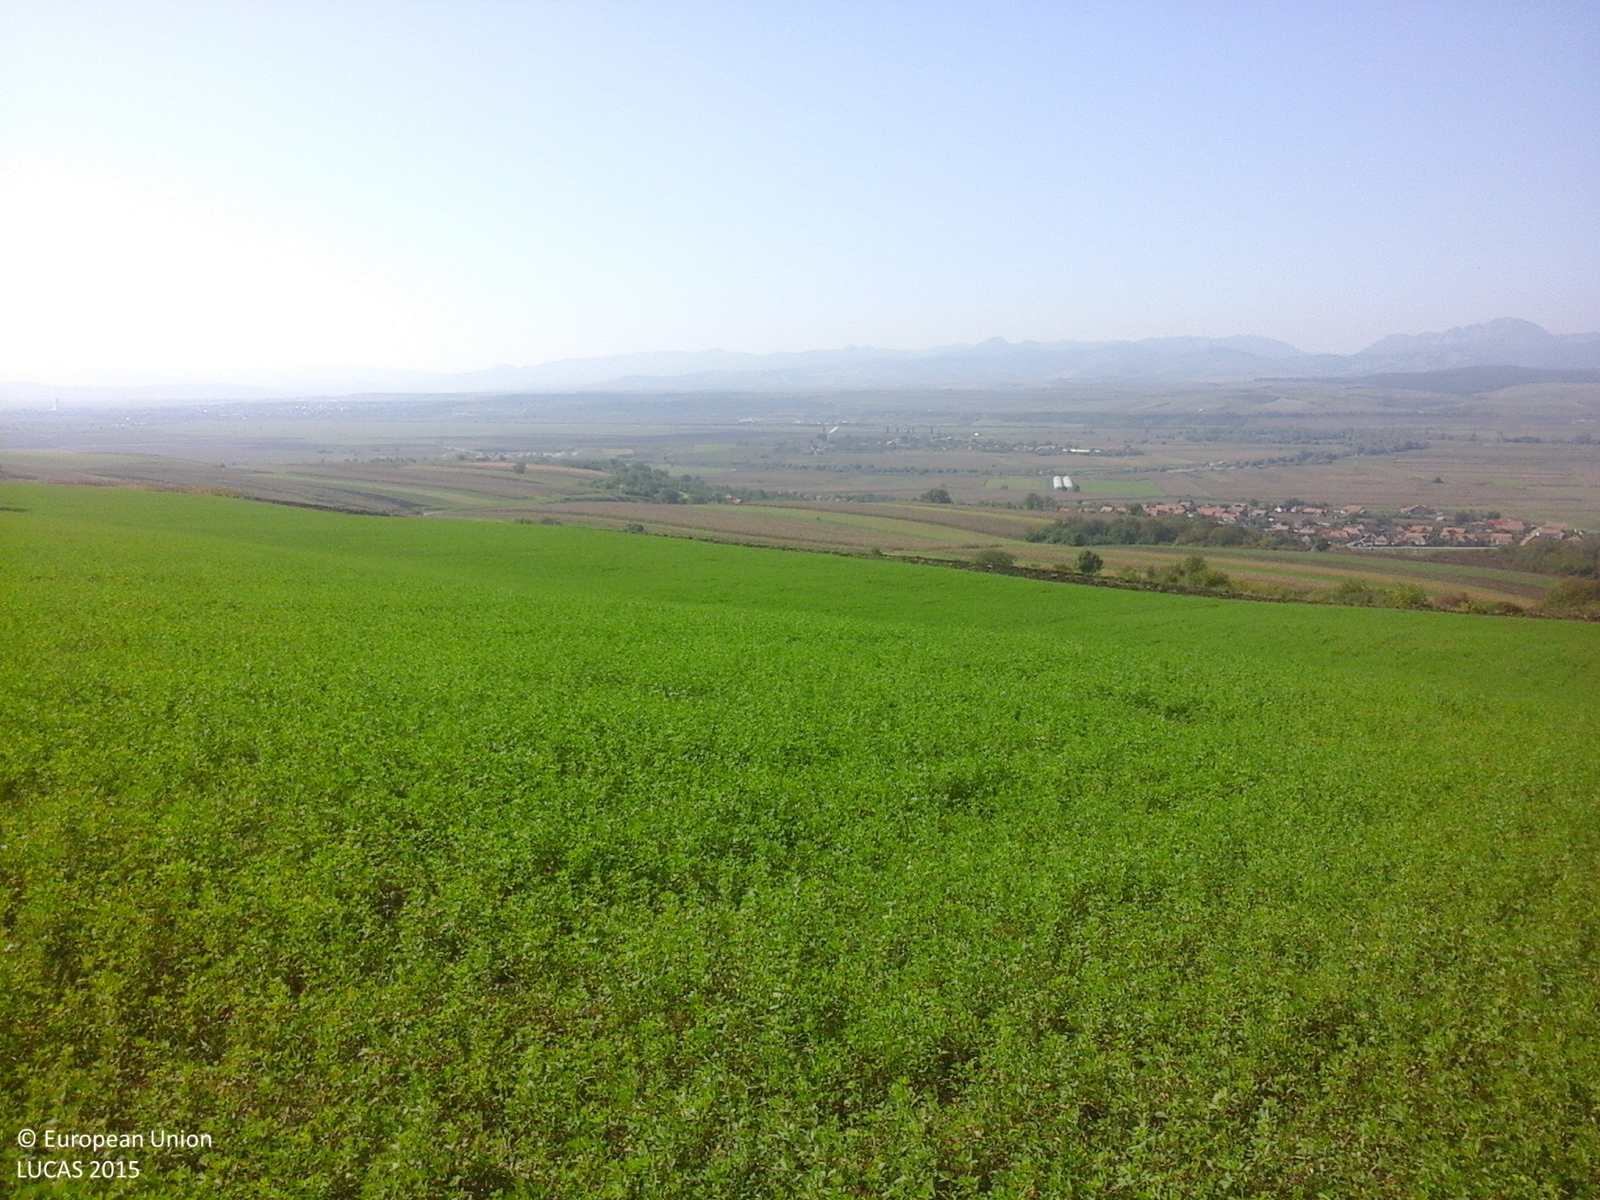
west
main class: Cropland
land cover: Lucerne
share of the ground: > 75 %
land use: Agriculture (excluding fallow land and kitchen gardens)
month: October
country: RO
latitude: 46.2429
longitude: 23.7532
